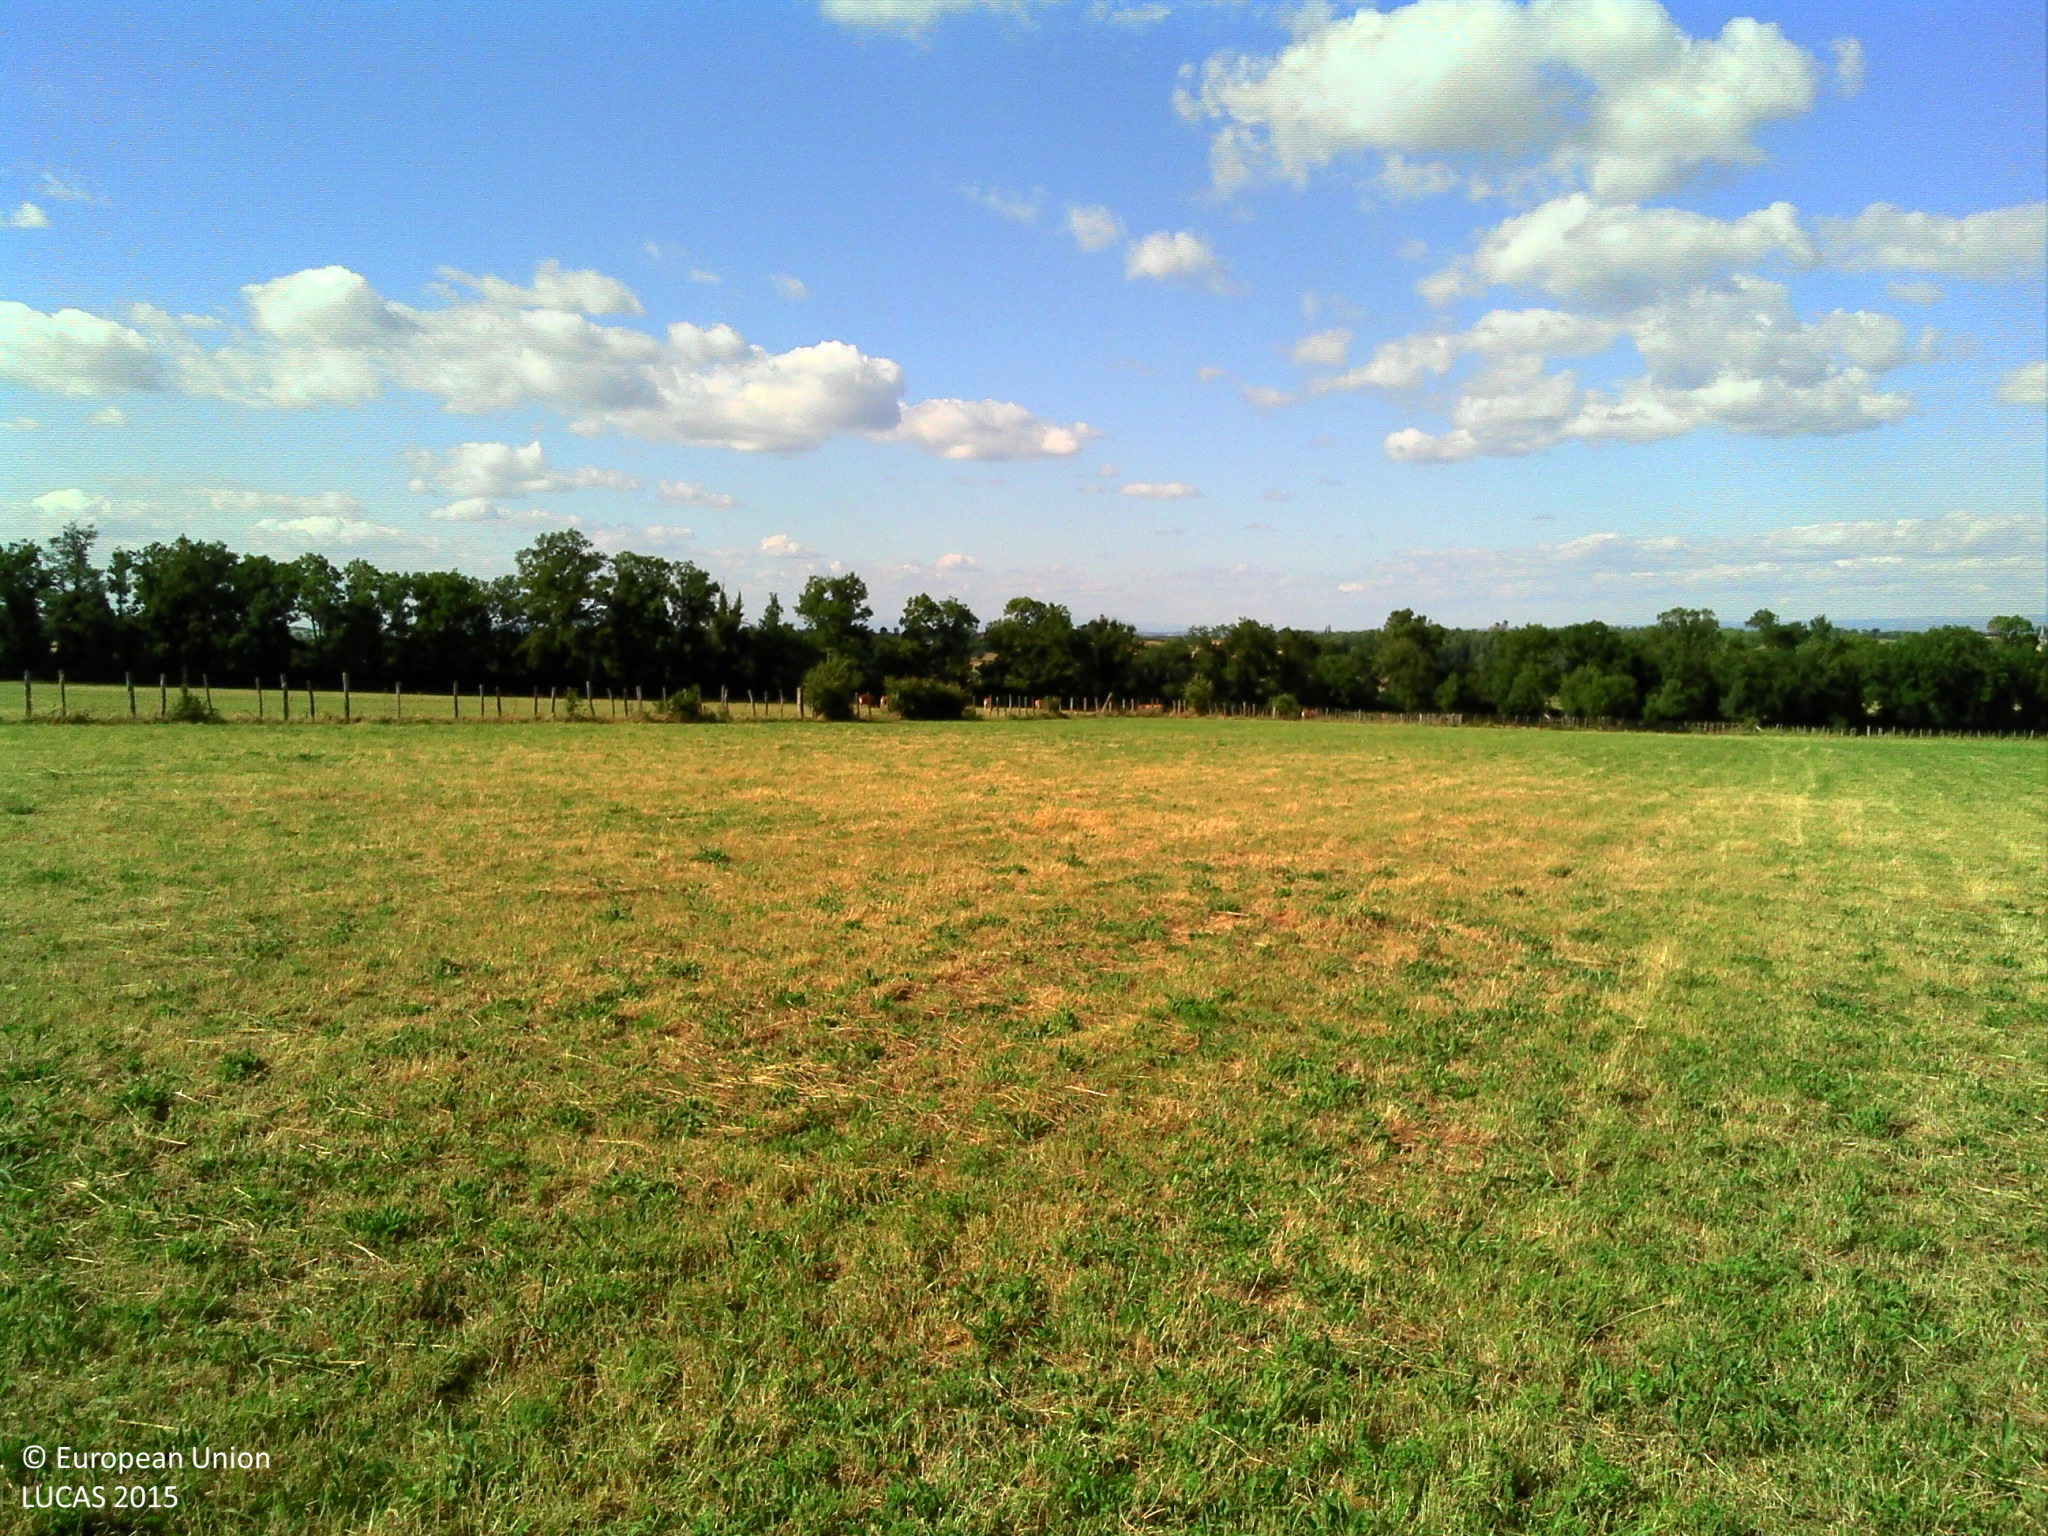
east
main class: Grassland
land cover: Grassland without tree/shrub cover
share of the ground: > 75 %
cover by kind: herbaceous plants 100 %
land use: Agriculture (excluding fallow land and kitchen gardens)
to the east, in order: Grassland without tree/shrub cover; Fences; Grassland without tree/shrub cover
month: June
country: FR
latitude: 44.3676
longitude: 2.4864
